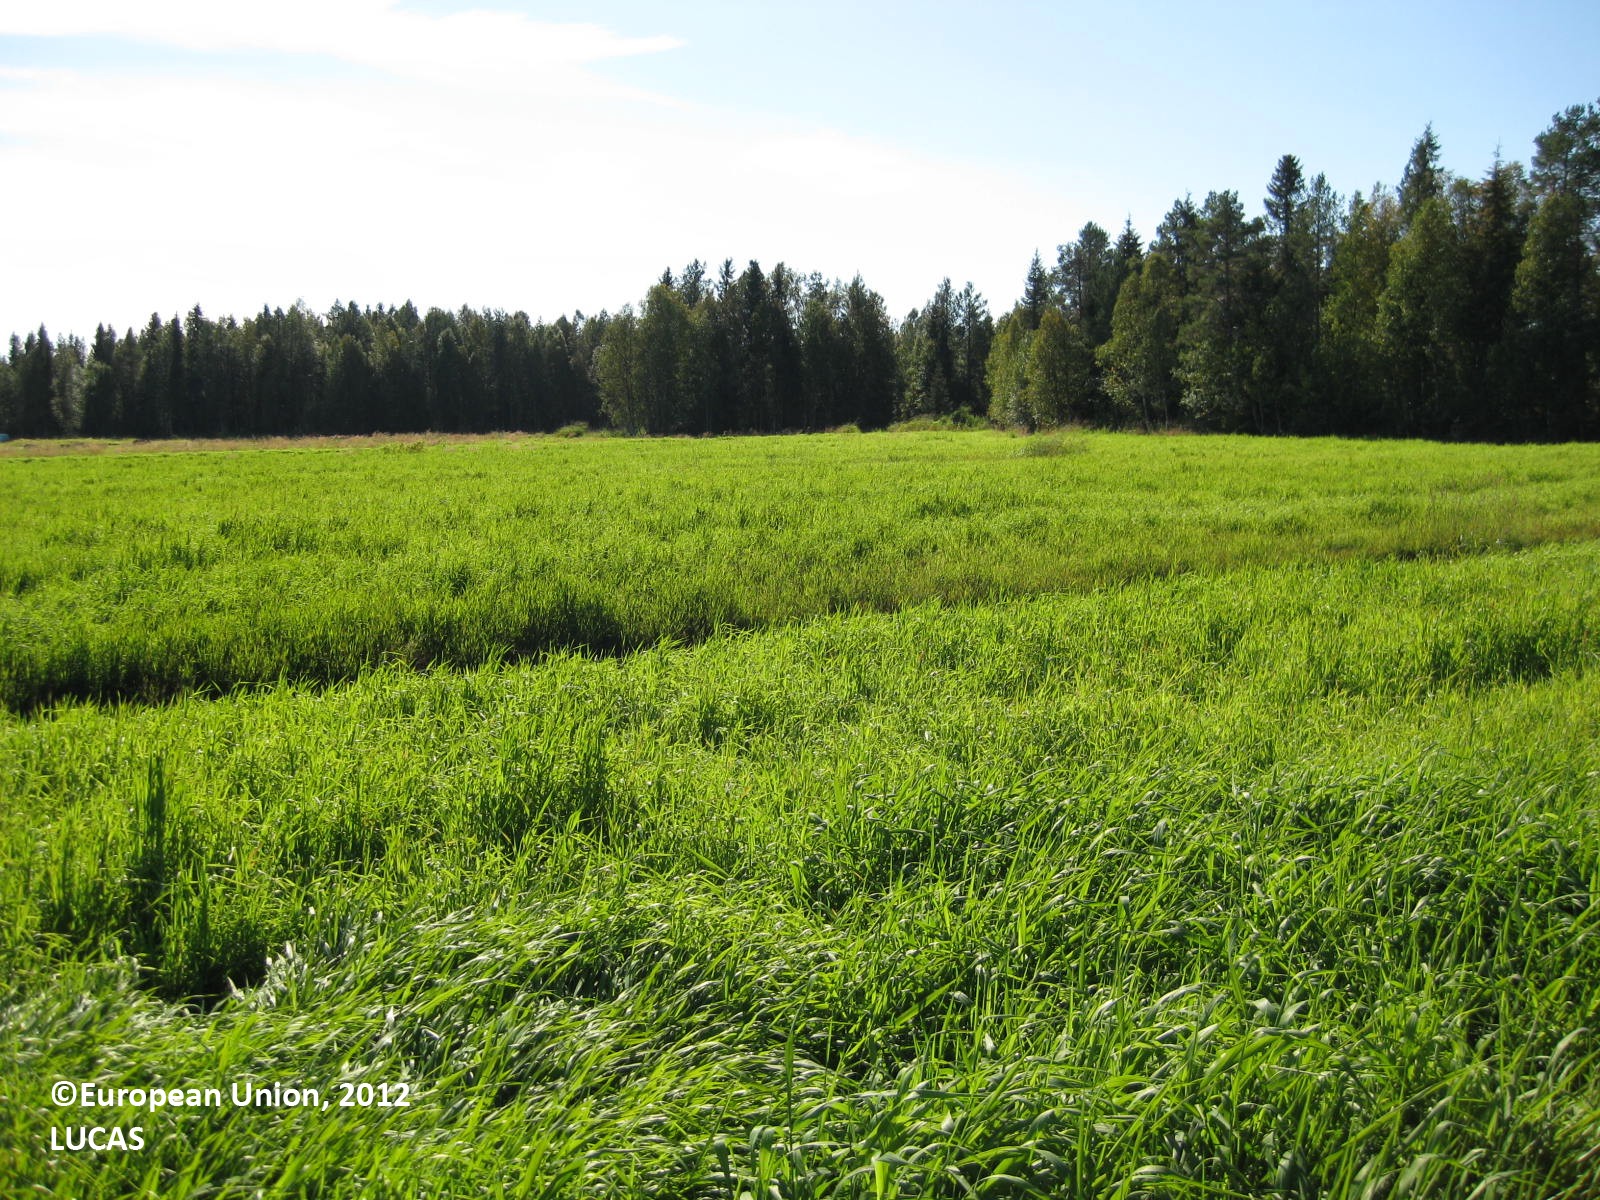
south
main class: Cropland
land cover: Temporary grasslands
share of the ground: > 75 %
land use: Agriculture (excluding fallow land and kitchen gardens)
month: August
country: FI
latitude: 66.0268
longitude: 29.7644
